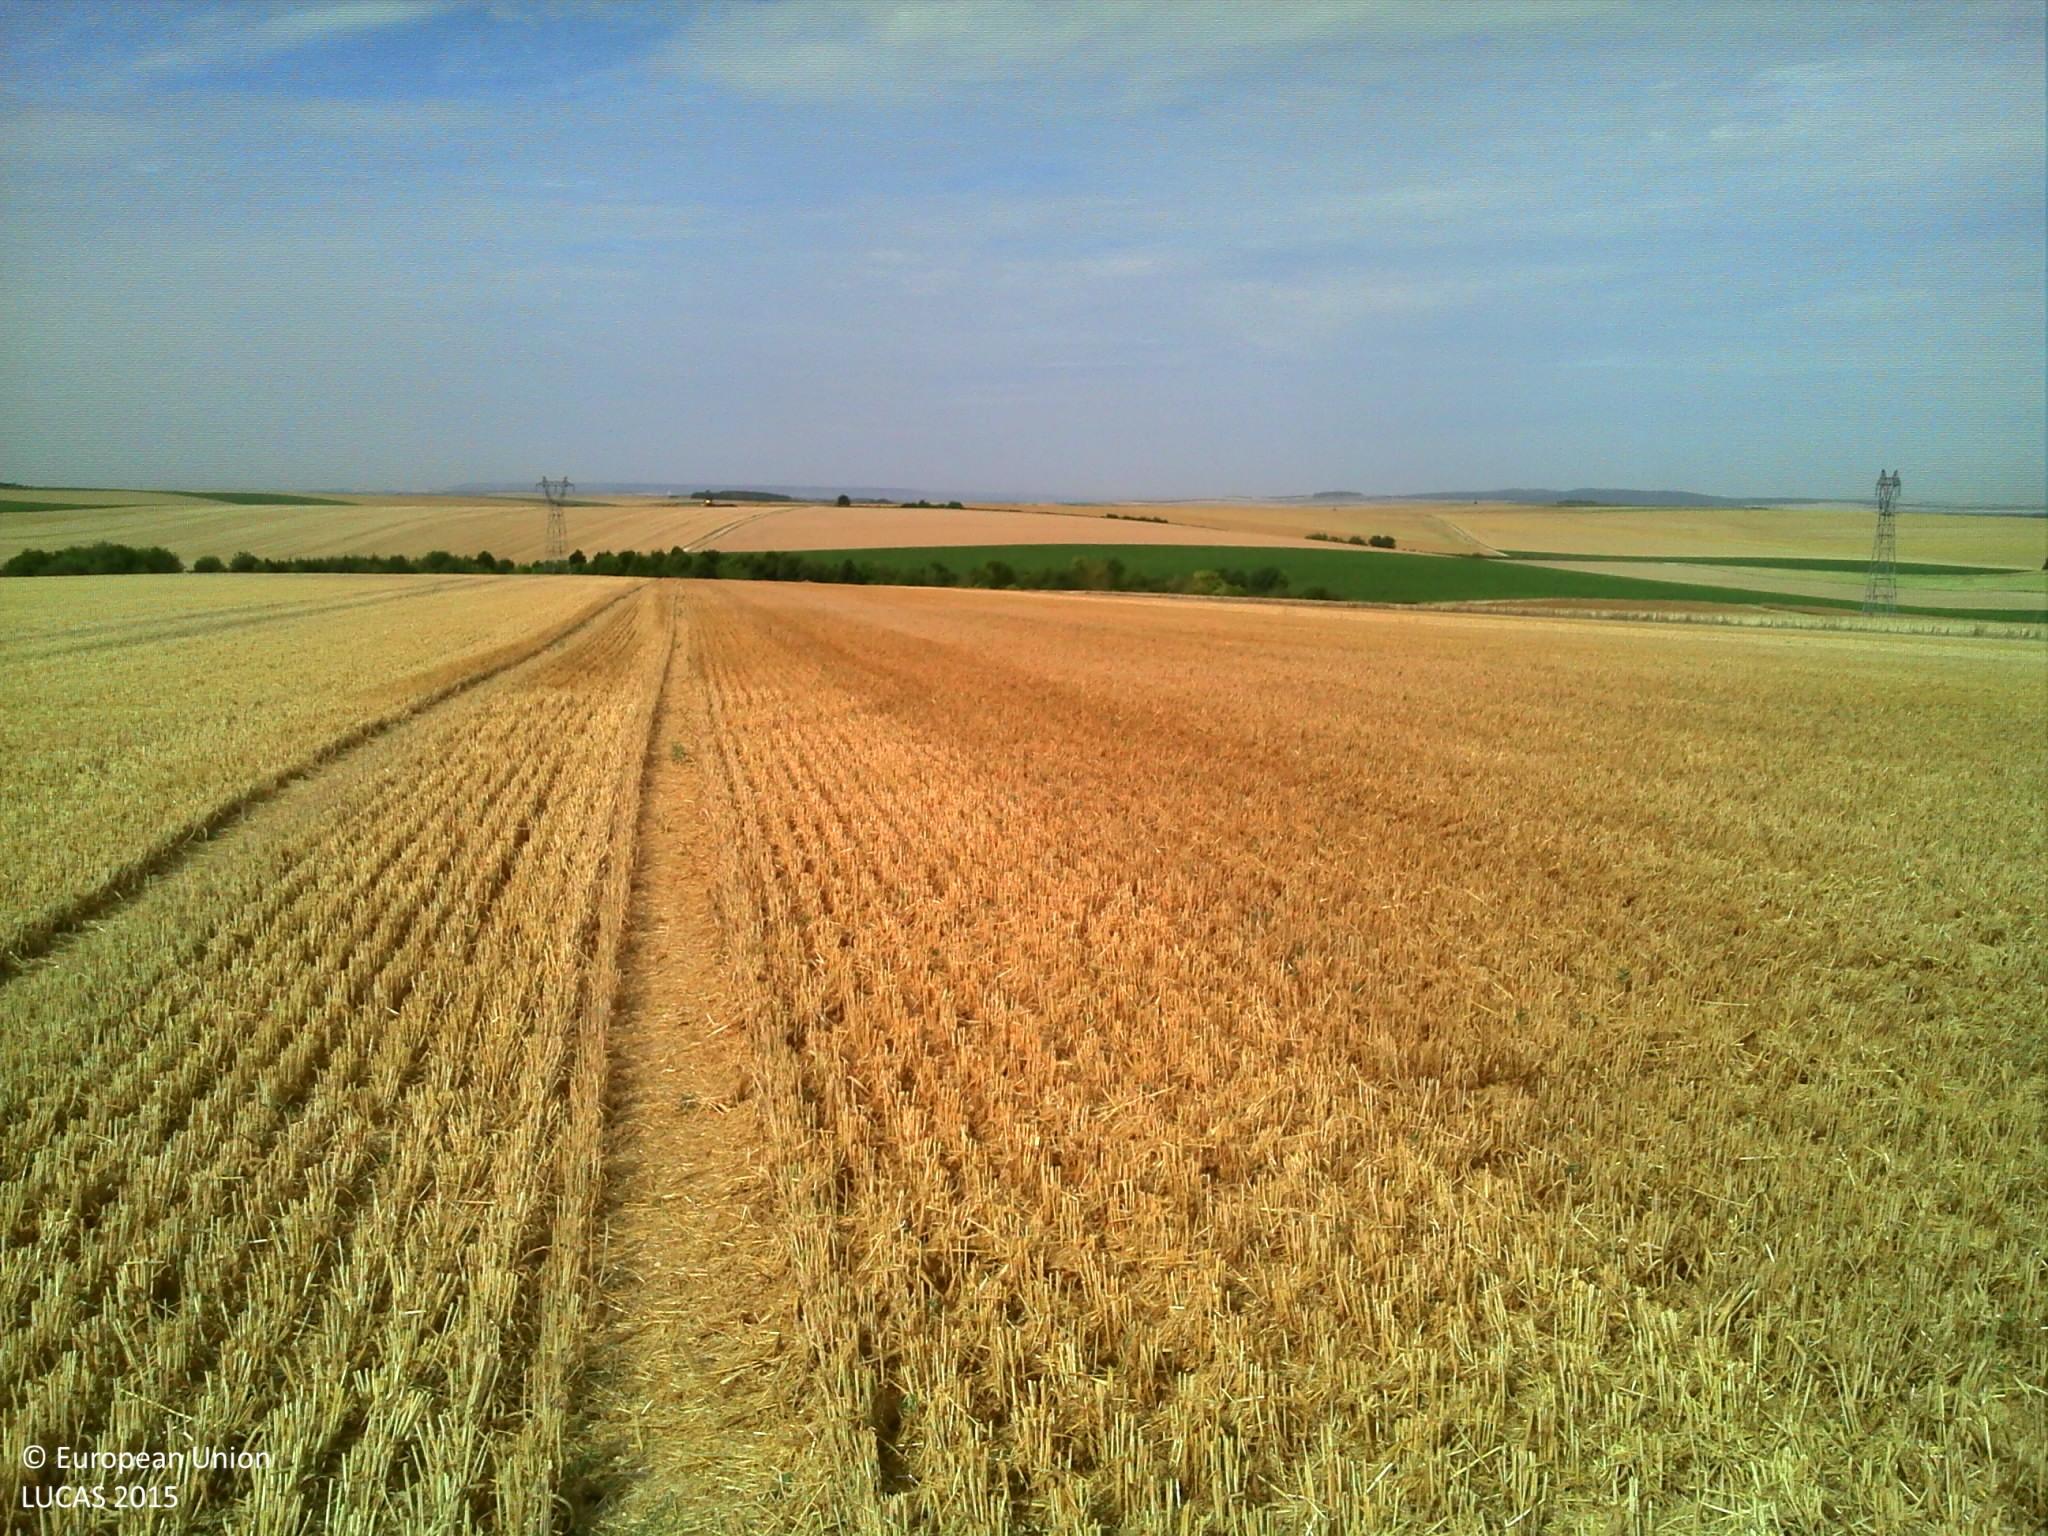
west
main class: Cropland
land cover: Barley
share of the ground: > 75 %
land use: Agriculture (excluding fallow land and kitchen gardens)
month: July
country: FR
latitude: 49.2232
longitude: 4.5181
